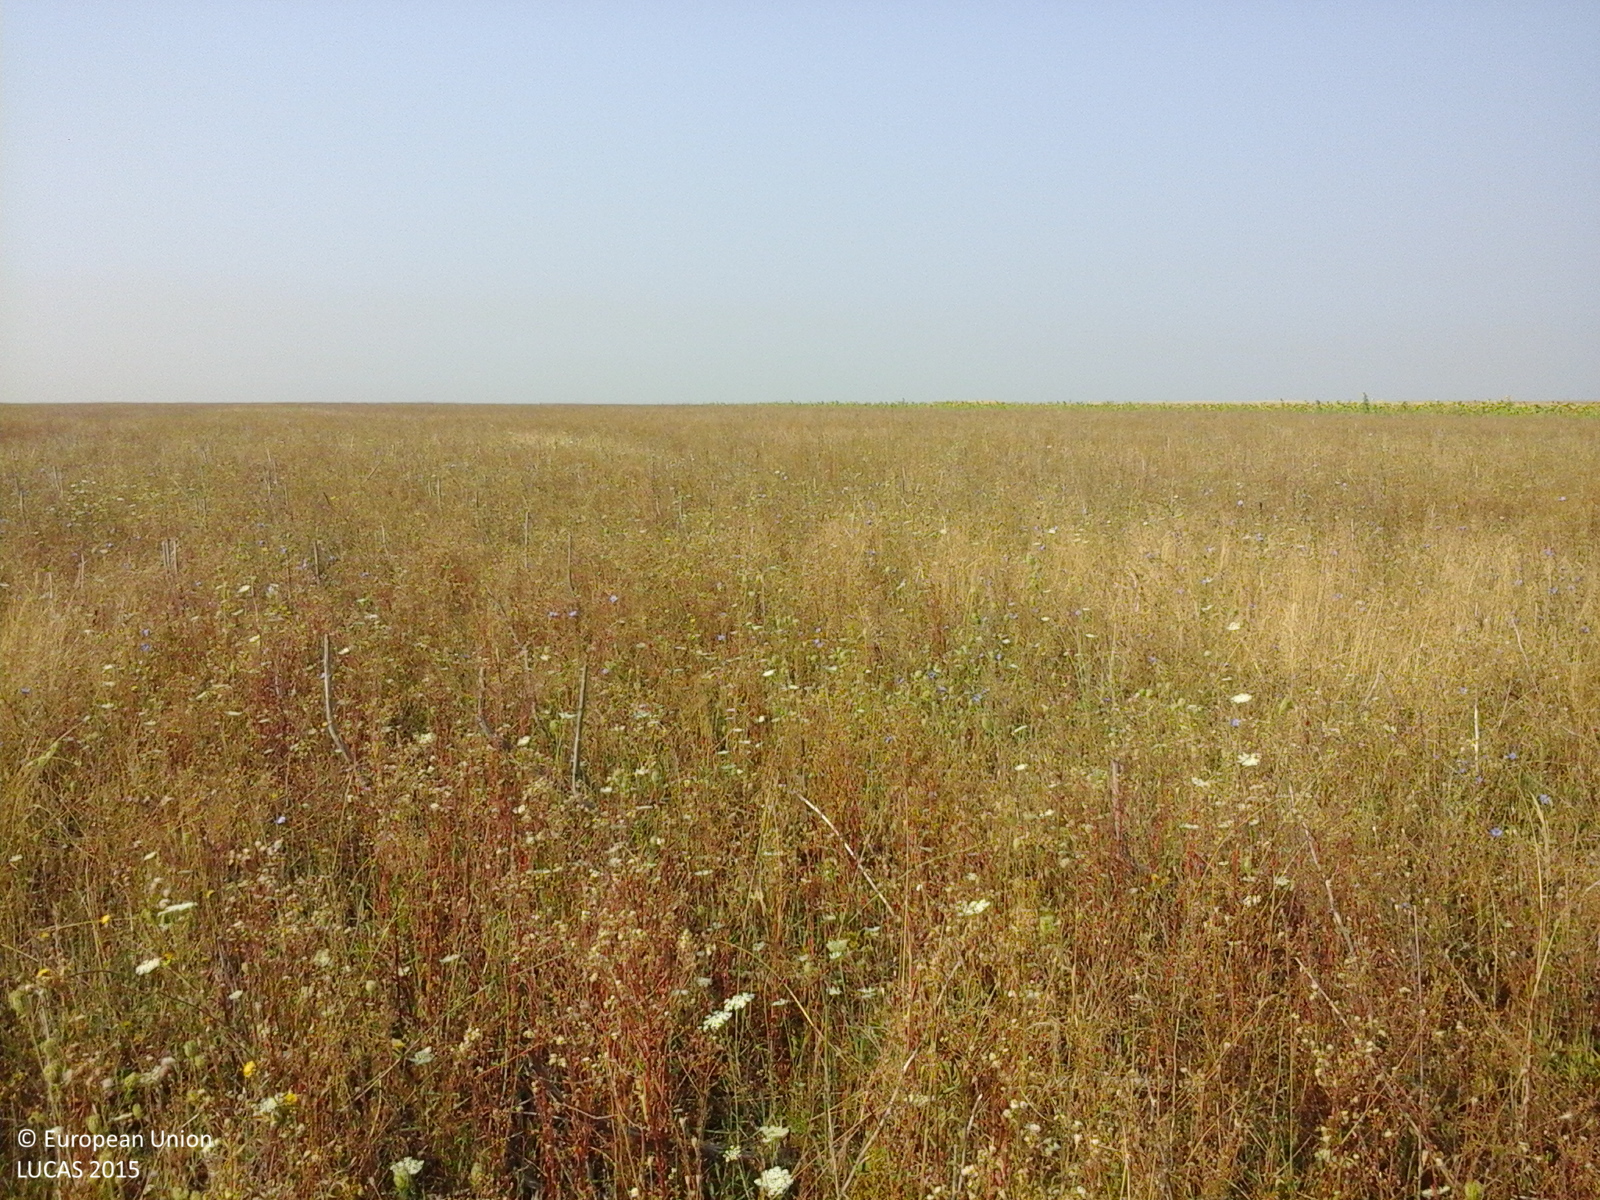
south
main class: Grassland
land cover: Spontaneously vegetated surfaces
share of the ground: > 75 %
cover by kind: herbaceous plants 100 %
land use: Fallow land
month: August
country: RO
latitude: 44.4725
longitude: 23.1849
